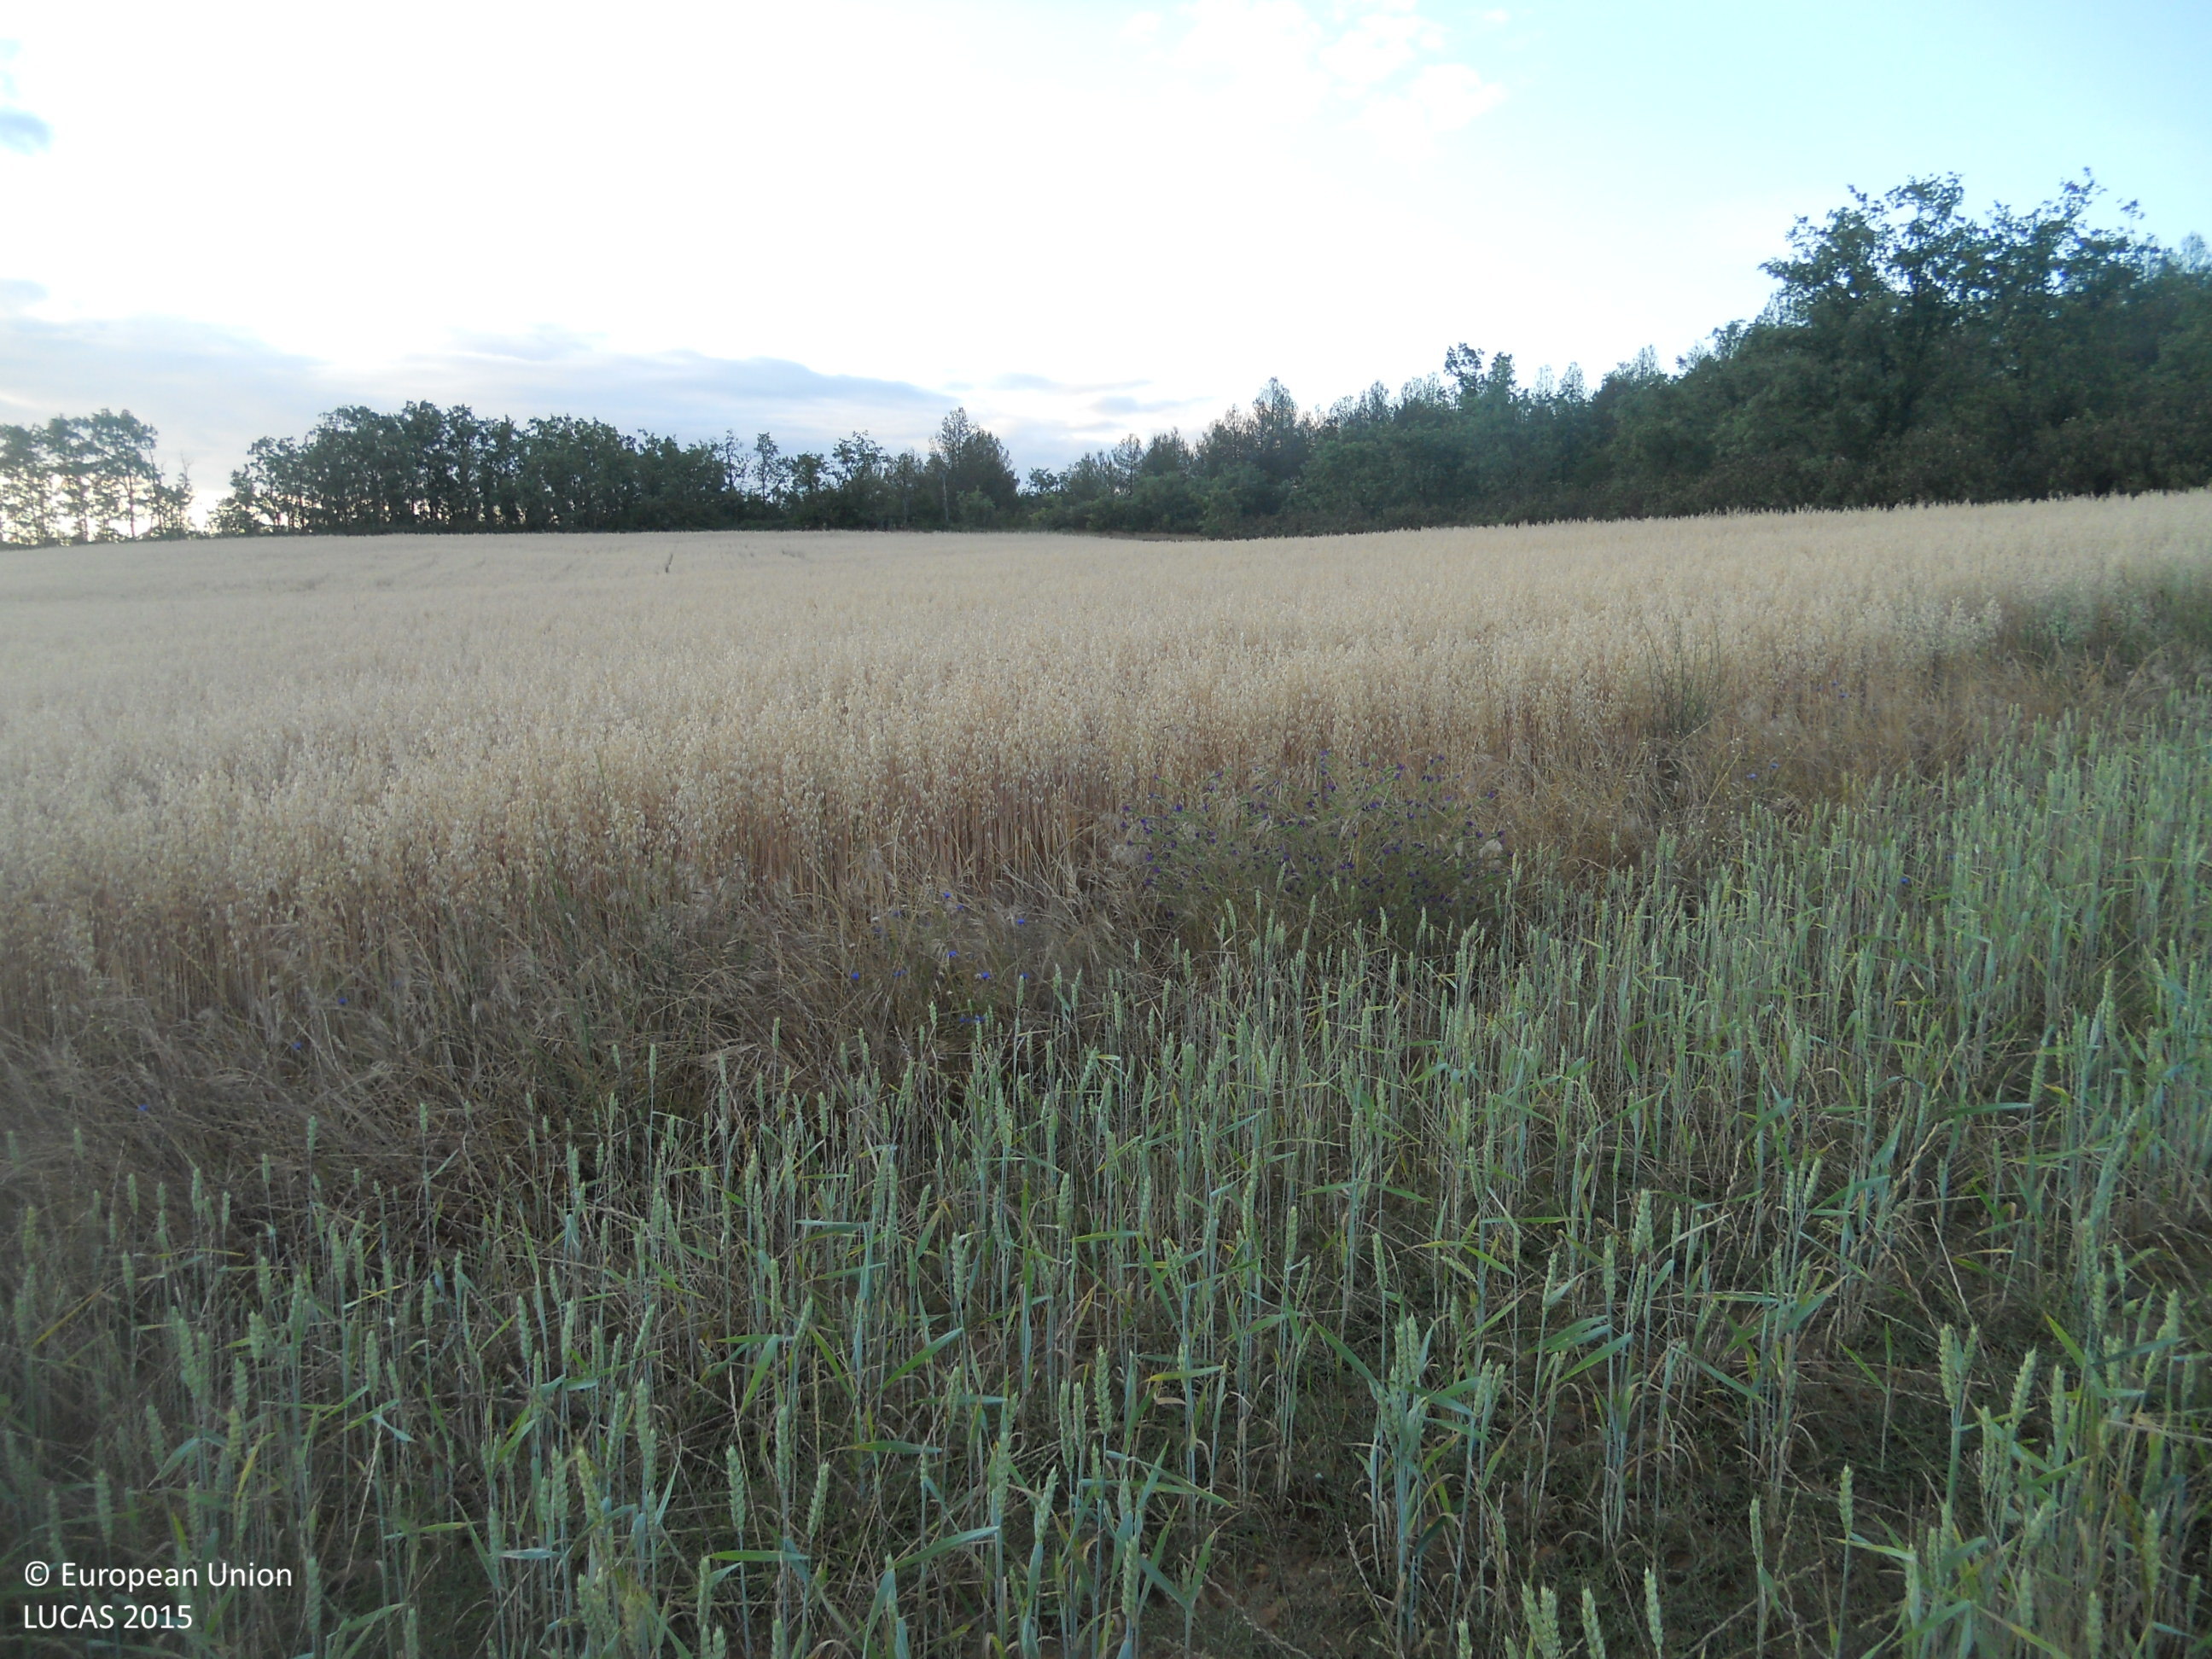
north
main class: Cropland
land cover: Common wheat
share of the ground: > 75 %
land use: Agriculture (excluding fallow land and kitchen gardens)
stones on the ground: < 10 %
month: June
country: ES
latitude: 42.3757
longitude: -4.8603
